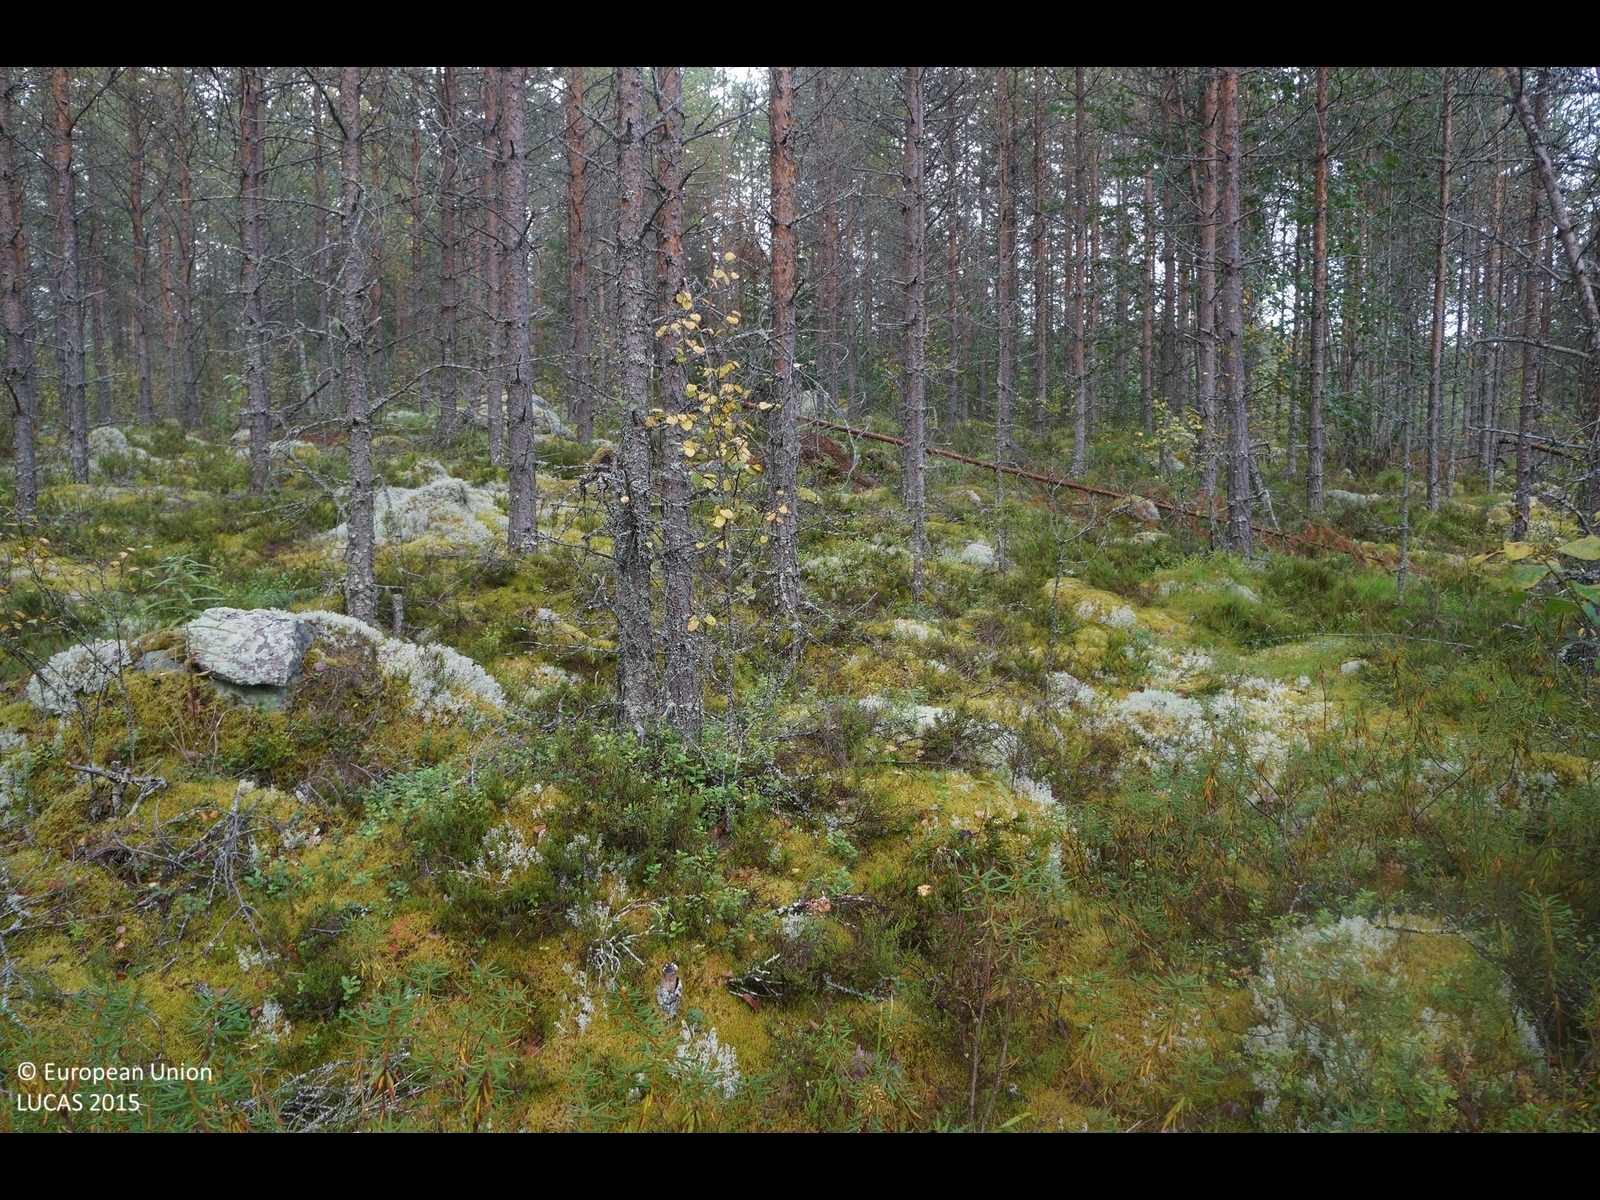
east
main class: Woodland
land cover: Pine dominated coniferous woodland
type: boreal forest
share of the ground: 50 - 75 %
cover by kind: coniferous forest trees 60 %, shrubs 20 %, lichens and mosses 15 %, herbaceous plants 5 %
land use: Forestry
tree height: > 5 m
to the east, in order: Pine dominated coniferous woodland; Ditches and canals; Pine dominated coniferous woodland; Ditches and canals; Pine dominated coniferous woodland; Pine dominated mixed woodland
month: September
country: FI
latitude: 63.8713
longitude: 24.3399
